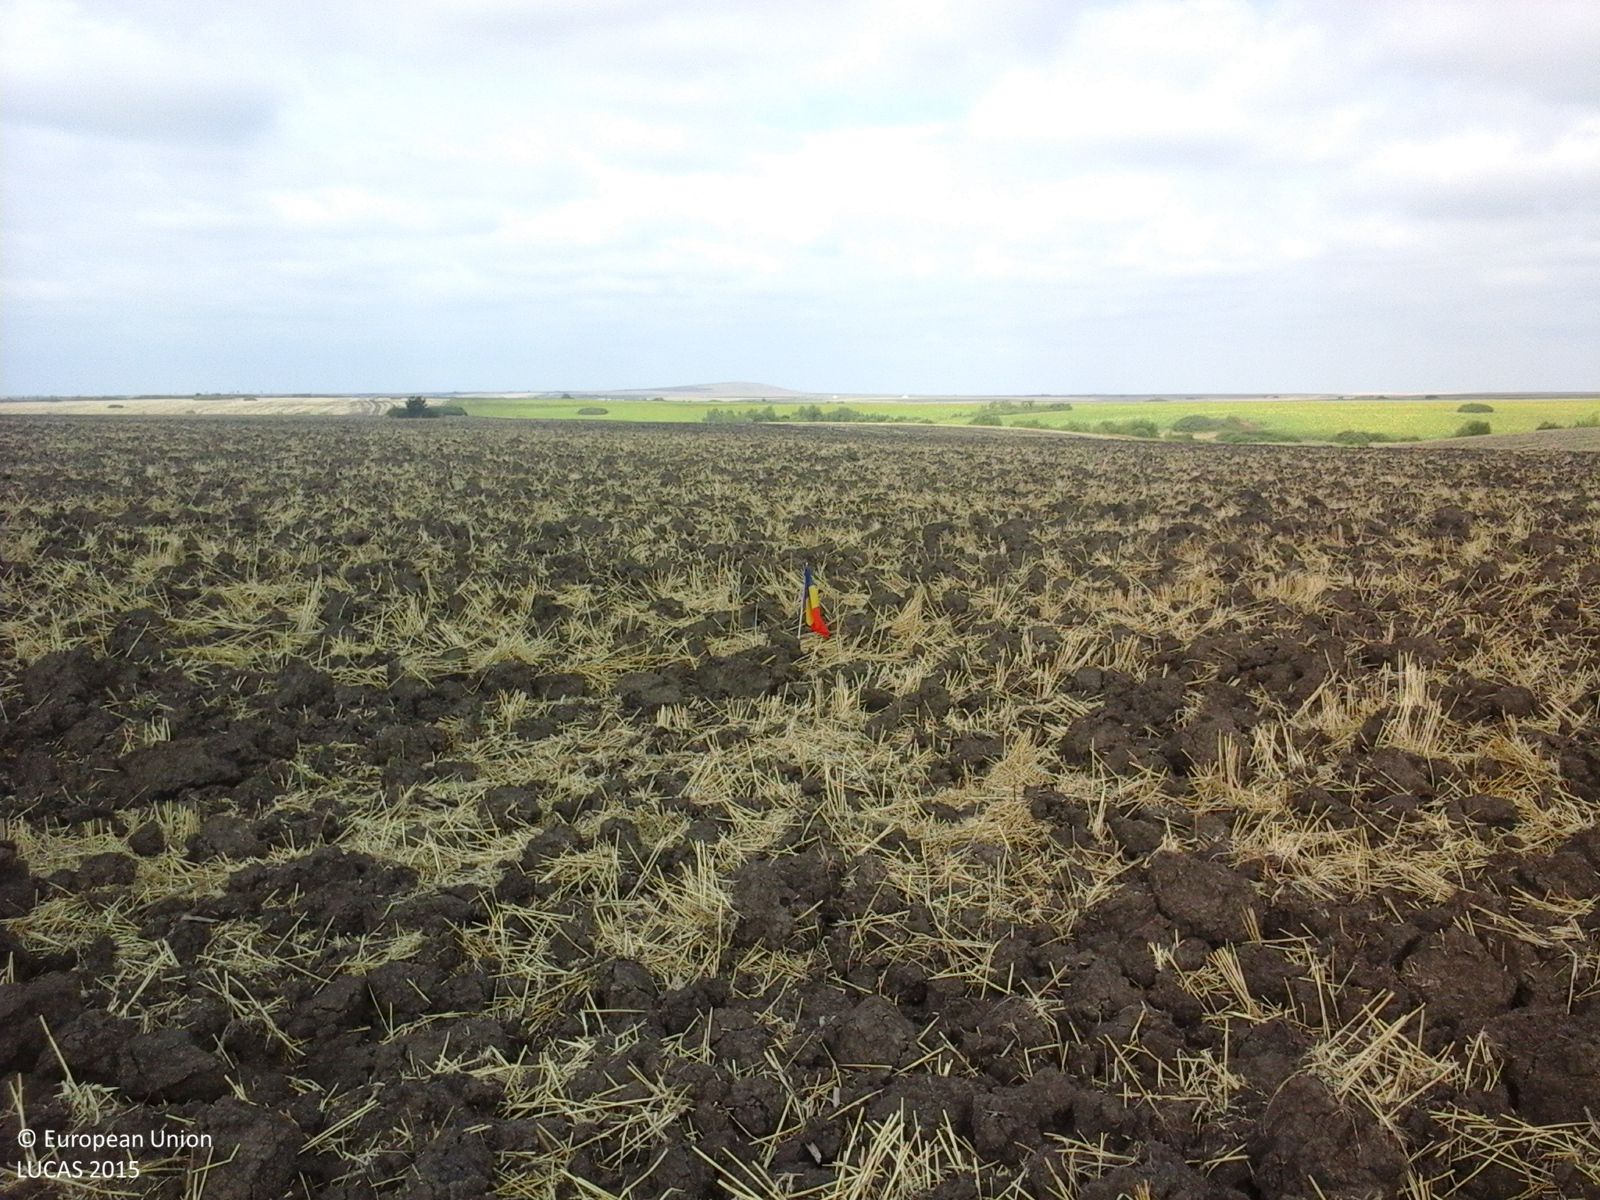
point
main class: Cropland
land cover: Common wheat
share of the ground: < 10 %
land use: Agriculture (excluding fallow land and kitchen gardens)
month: August
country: RO
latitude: 45.3640
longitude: 21.5090
